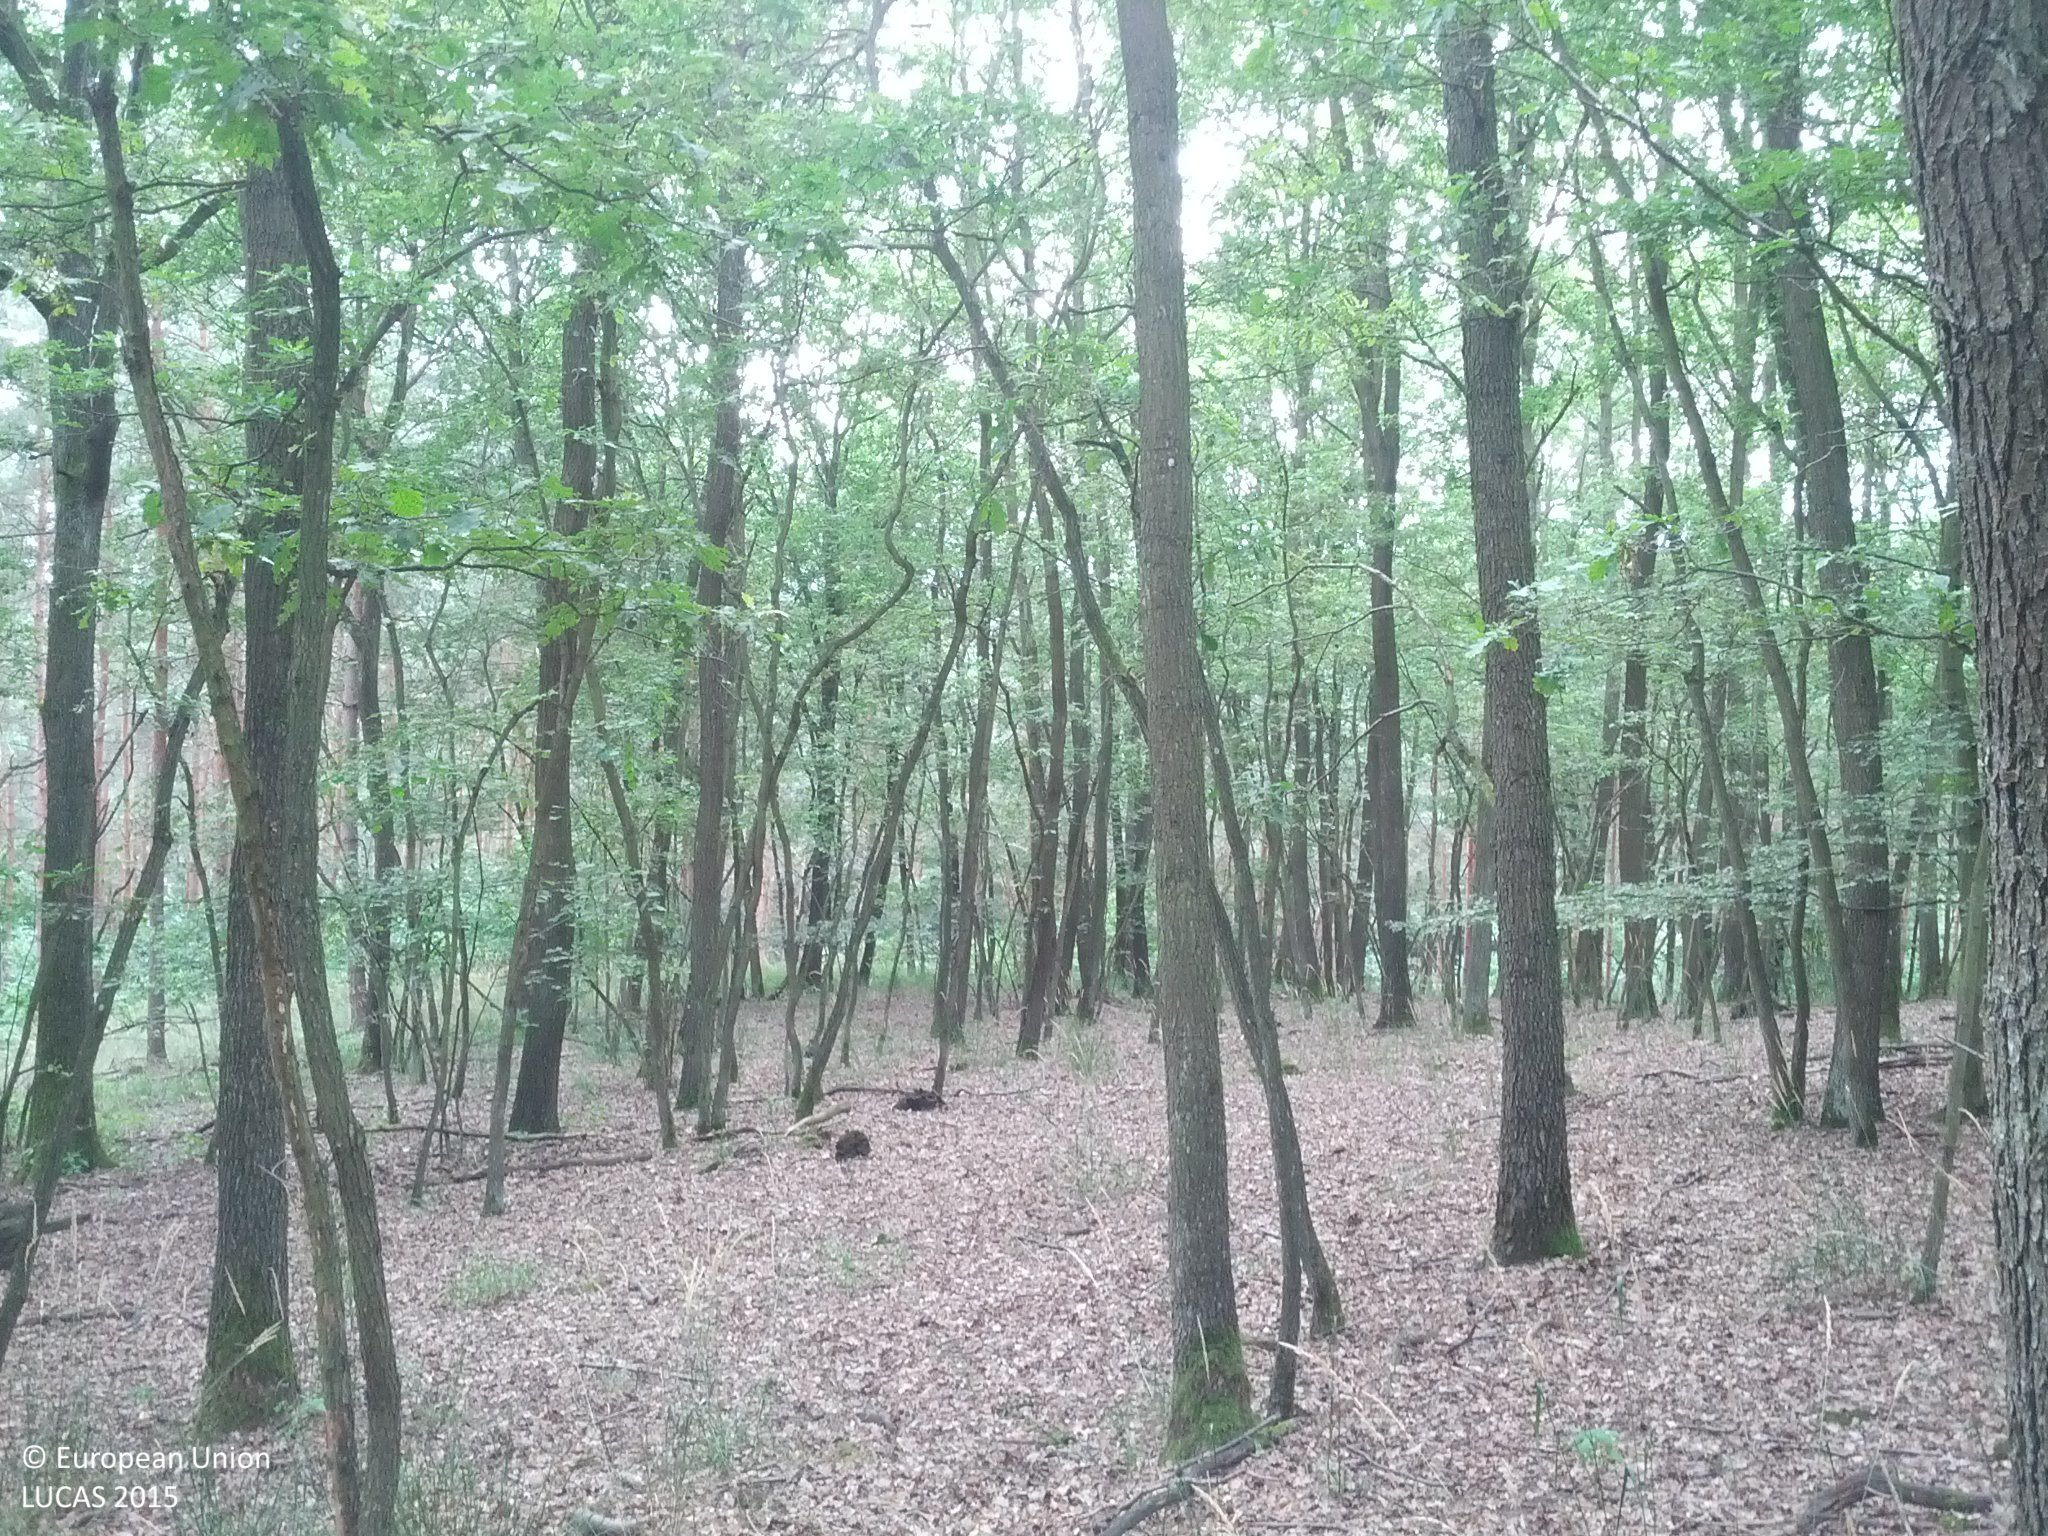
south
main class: Woodland
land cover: Broadleaved woodland
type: acidophilous oak and oak-birch forest
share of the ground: > 75 %
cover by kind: broadleaved forest trees 90 %, herbaceous plants 10 %
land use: Forestry
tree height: > 5 m
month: July
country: AT
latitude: 48.5396
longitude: 16.1403
